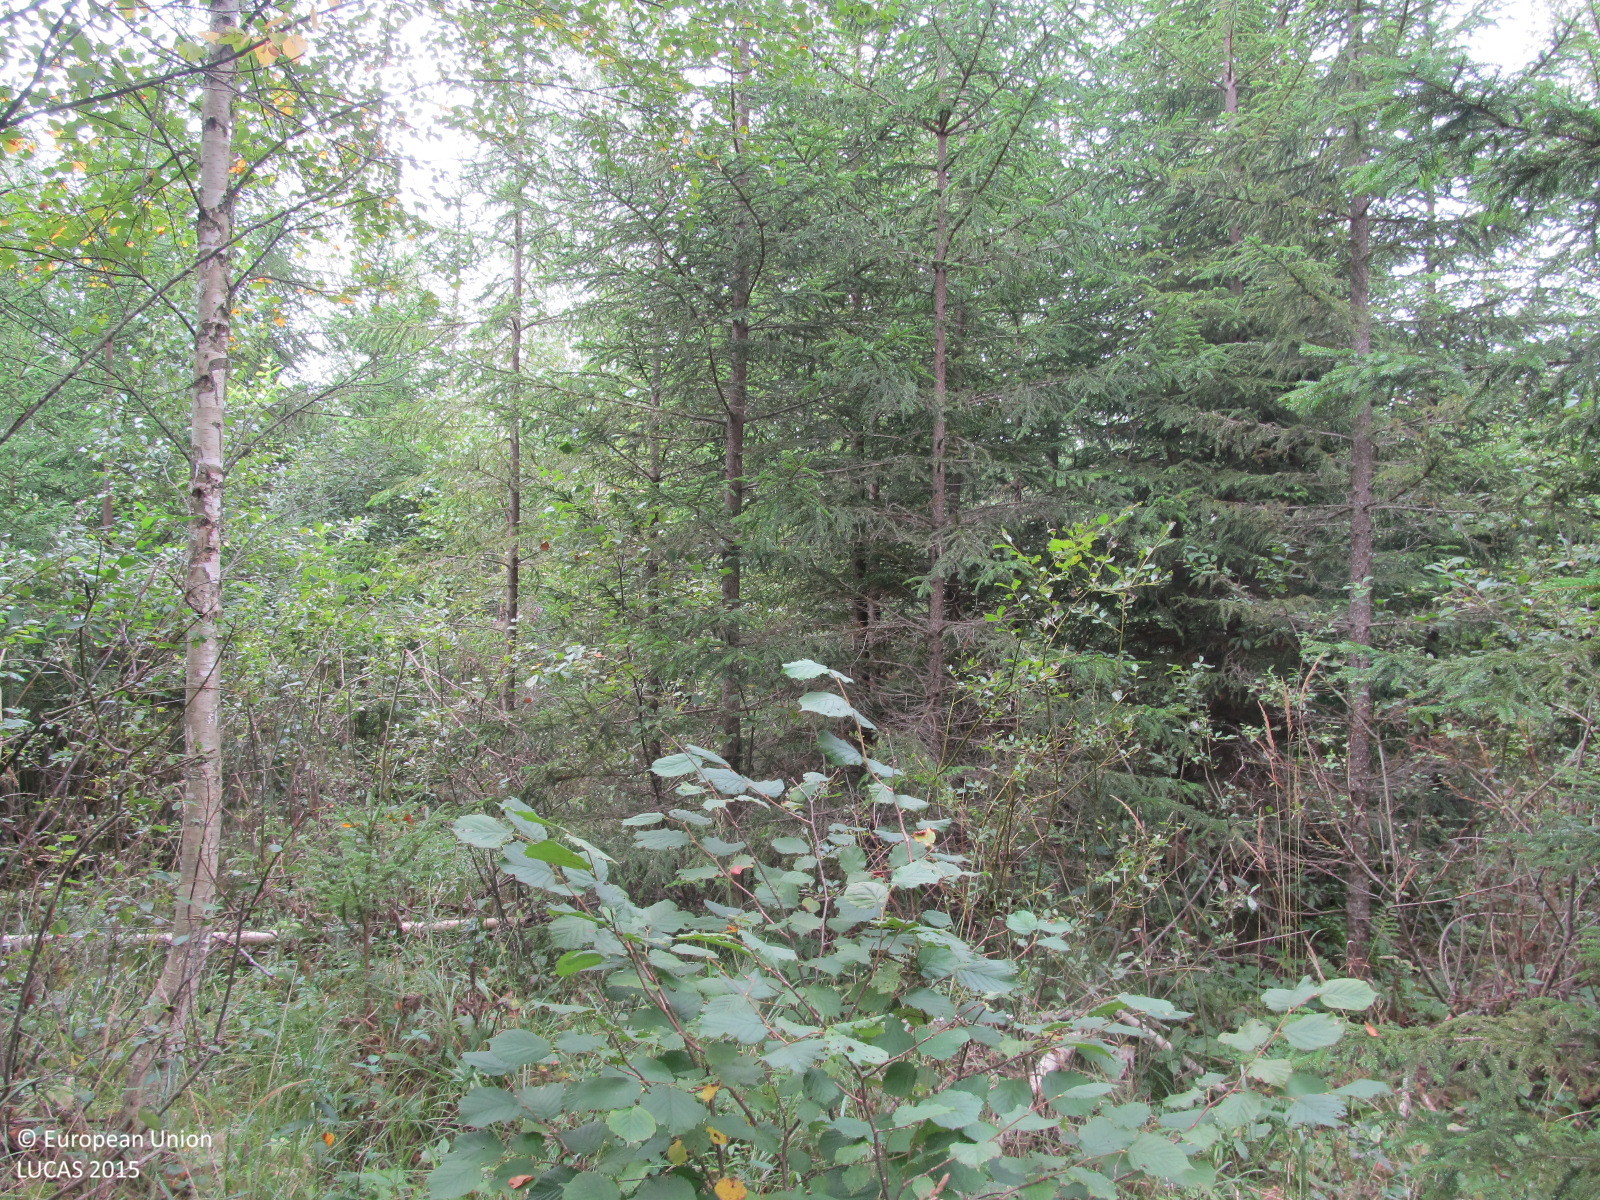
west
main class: Woodland
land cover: Spruce dominated mixed woodland
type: hemiboreal forest and nemoral coniferous forest and mixed broadleaved-coniferous forest
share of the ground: > 75 %
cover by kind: coniferous forest trees 50 %, broadleaved forest trees 30 %, shrubs 10 %, herbaceous plants 5 %, lichens and mosses 5 %
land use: Forestry
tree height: > 5 m
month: September
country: LT
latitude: 56.2862
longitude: 23.2040
